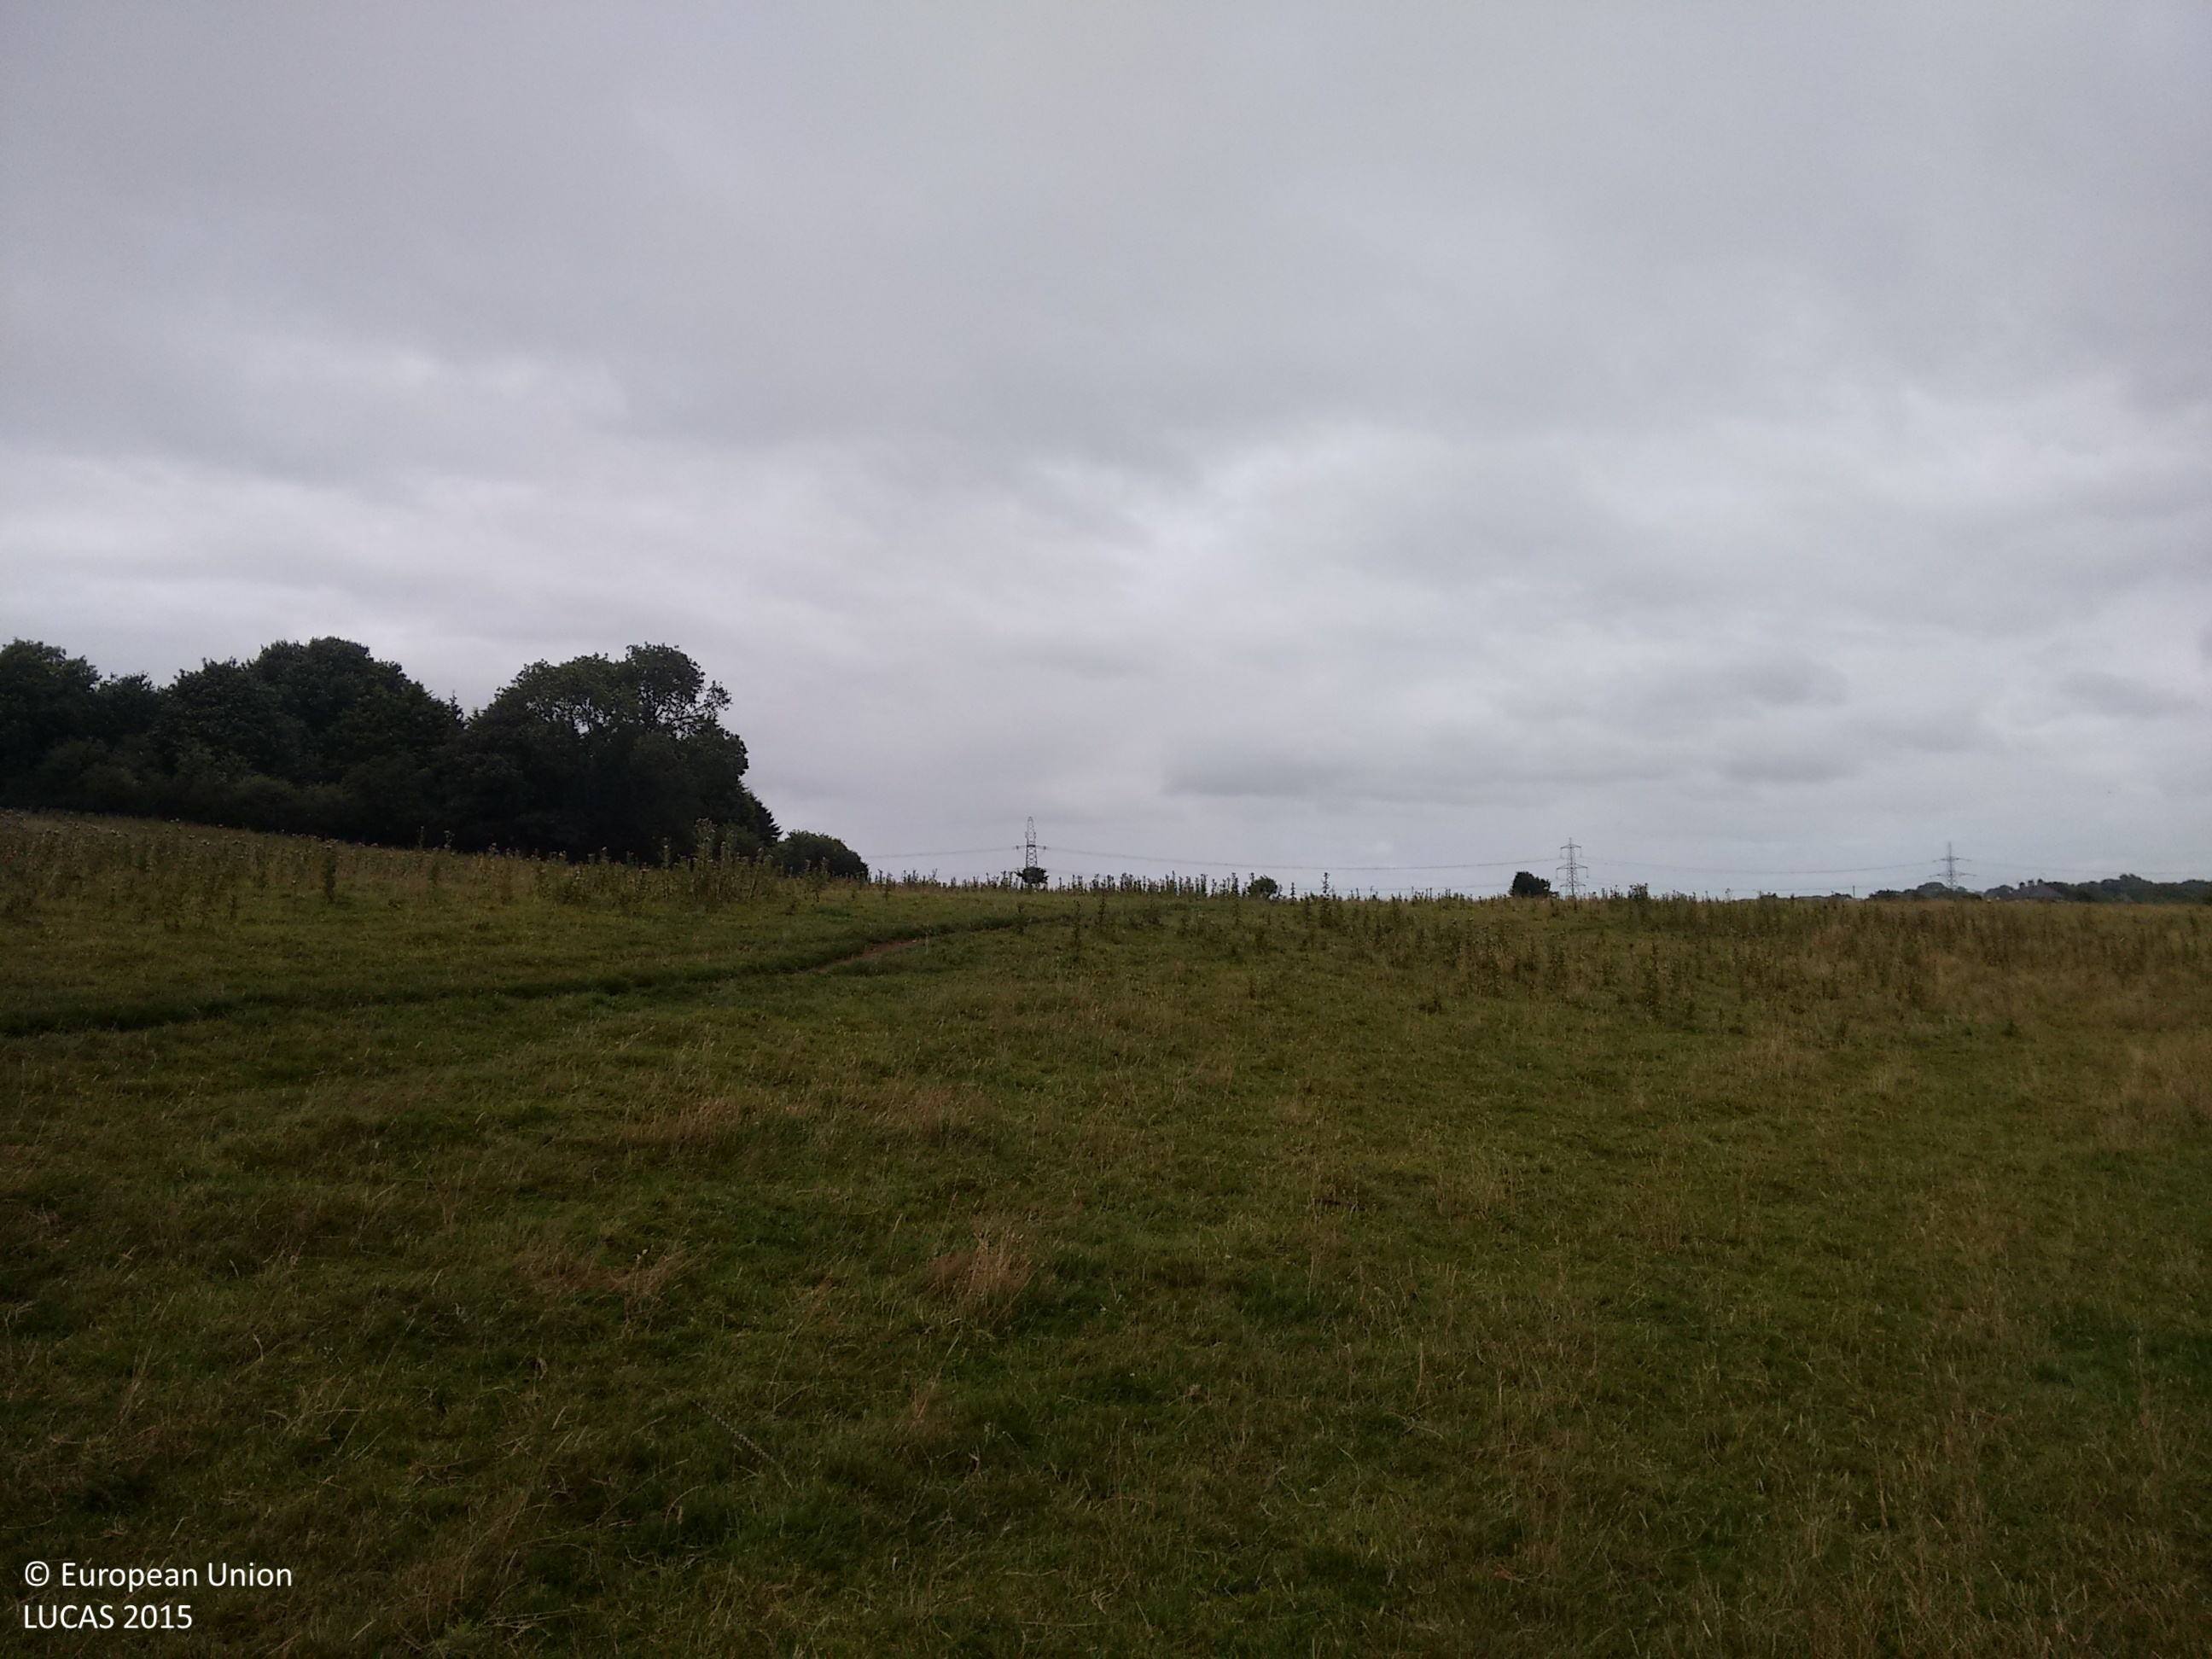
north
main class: Grassland
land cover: Grassland without tree/shrub cover
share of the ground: > 75 %
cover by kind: herbaceous plants 100 %
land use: Agriculture (excluding fallow land and kitchen gardens)
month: August
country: GB
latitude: 53.2146
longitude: -4.2202
